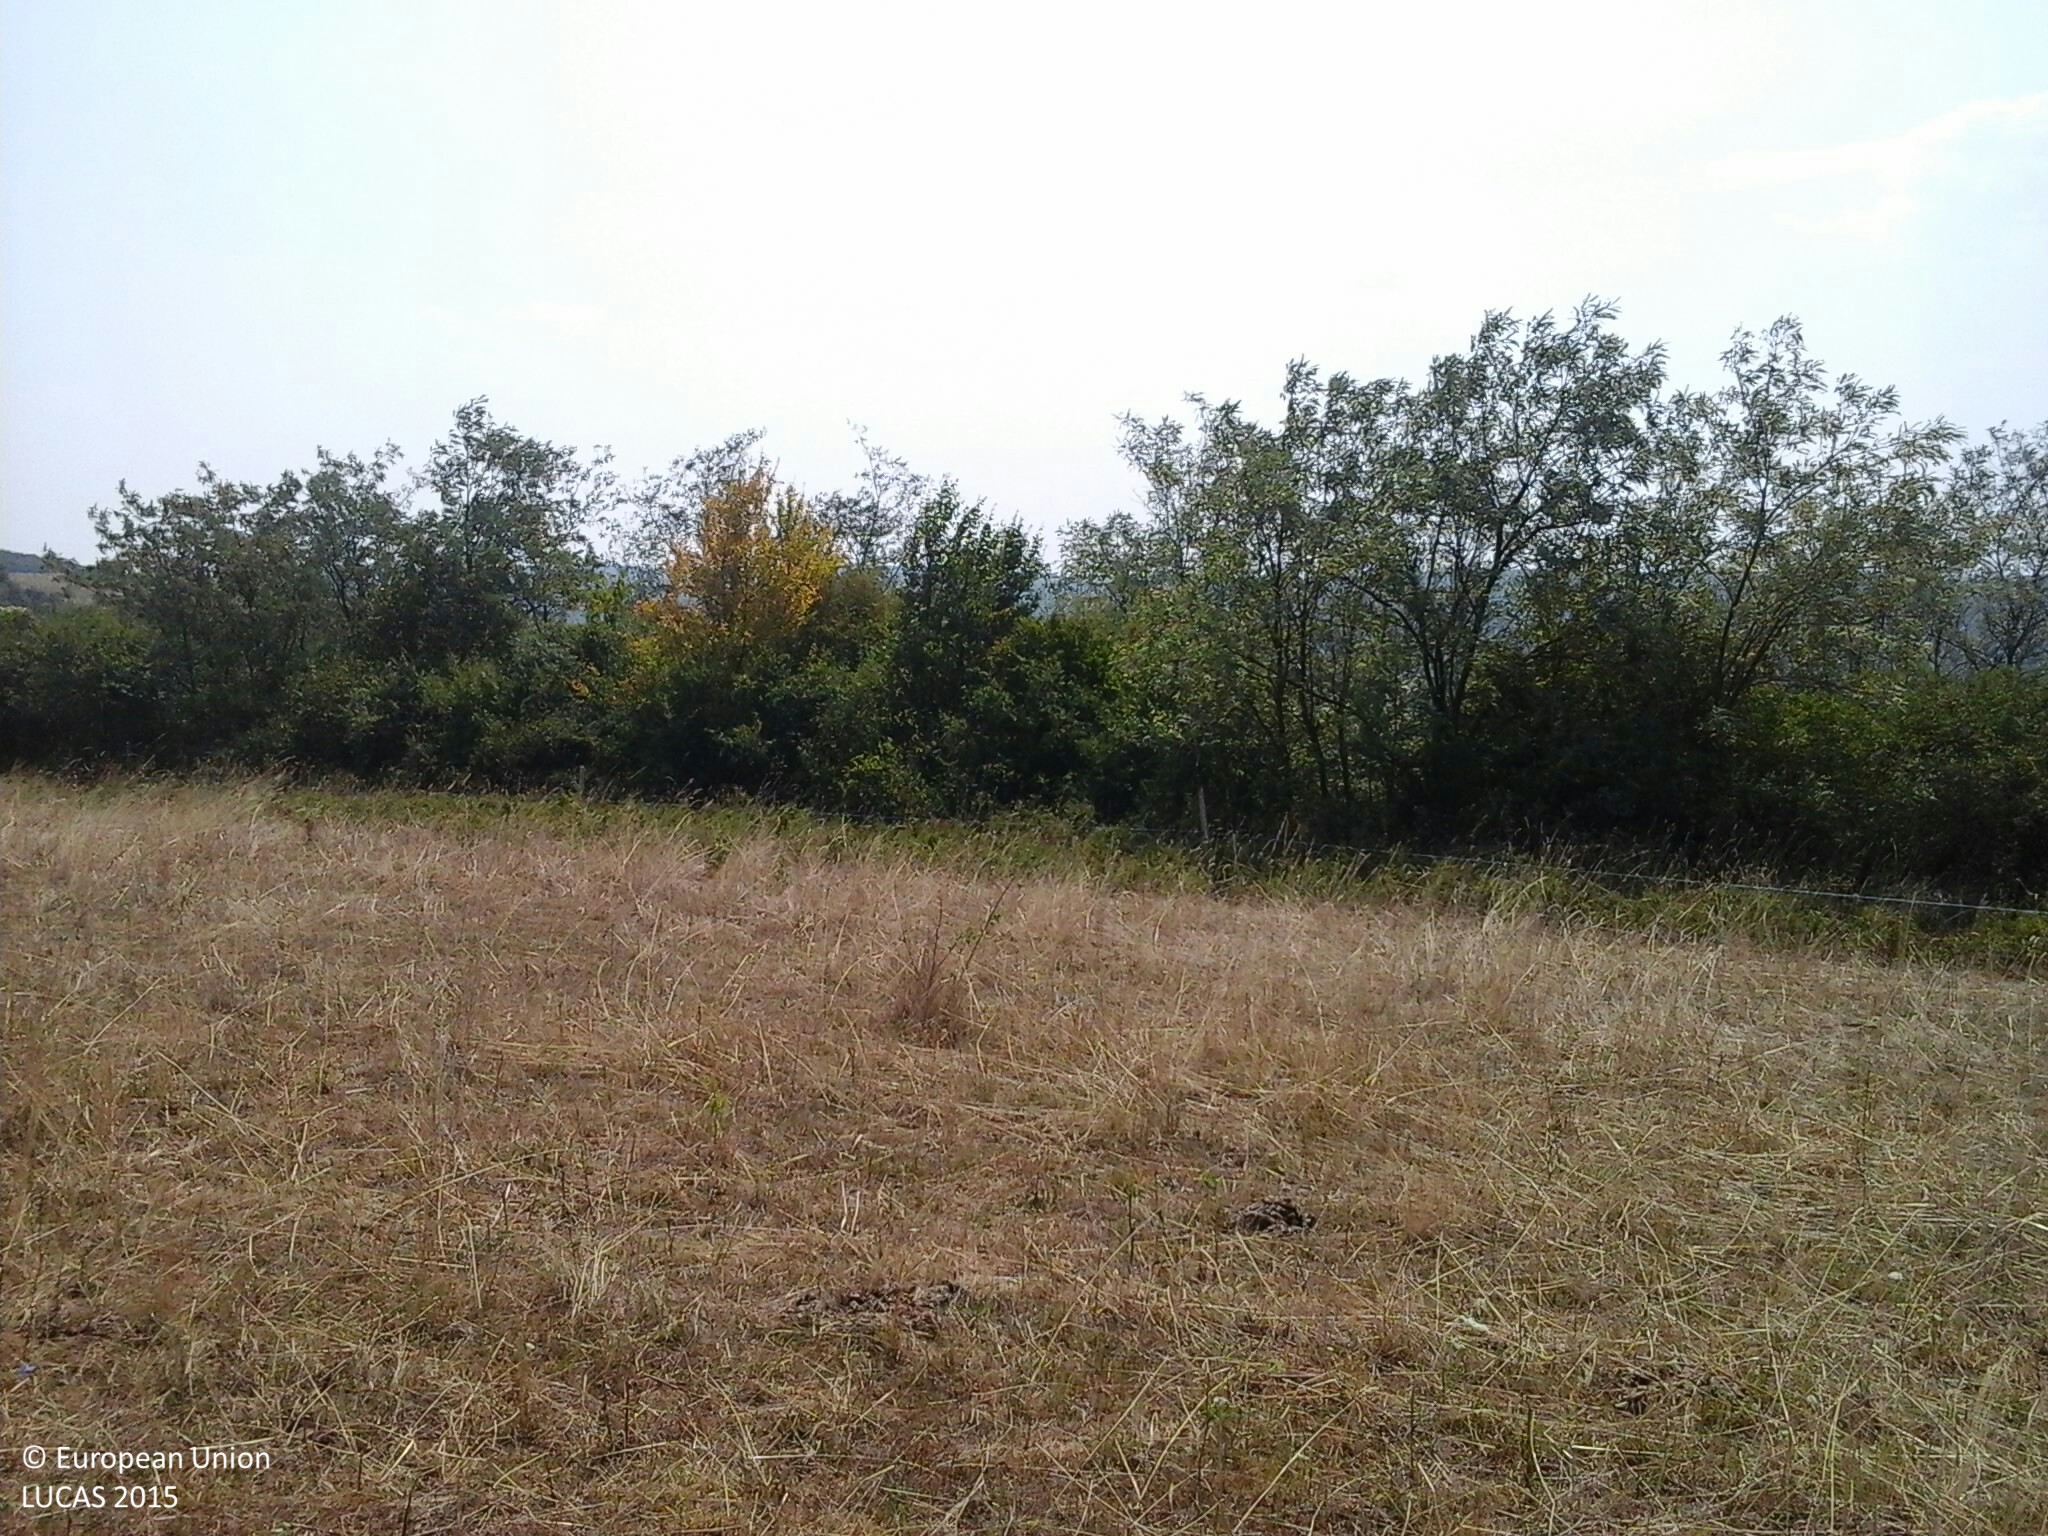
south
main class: Grassland
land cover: Grassland without tree/shrub cover
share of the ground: > 75 %
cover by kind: herbaceous plants 100 %
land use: Agriculture (excluding fallow land and kitchen gardens)
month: August
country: HU
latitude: 48.4071
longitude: 20.5314
